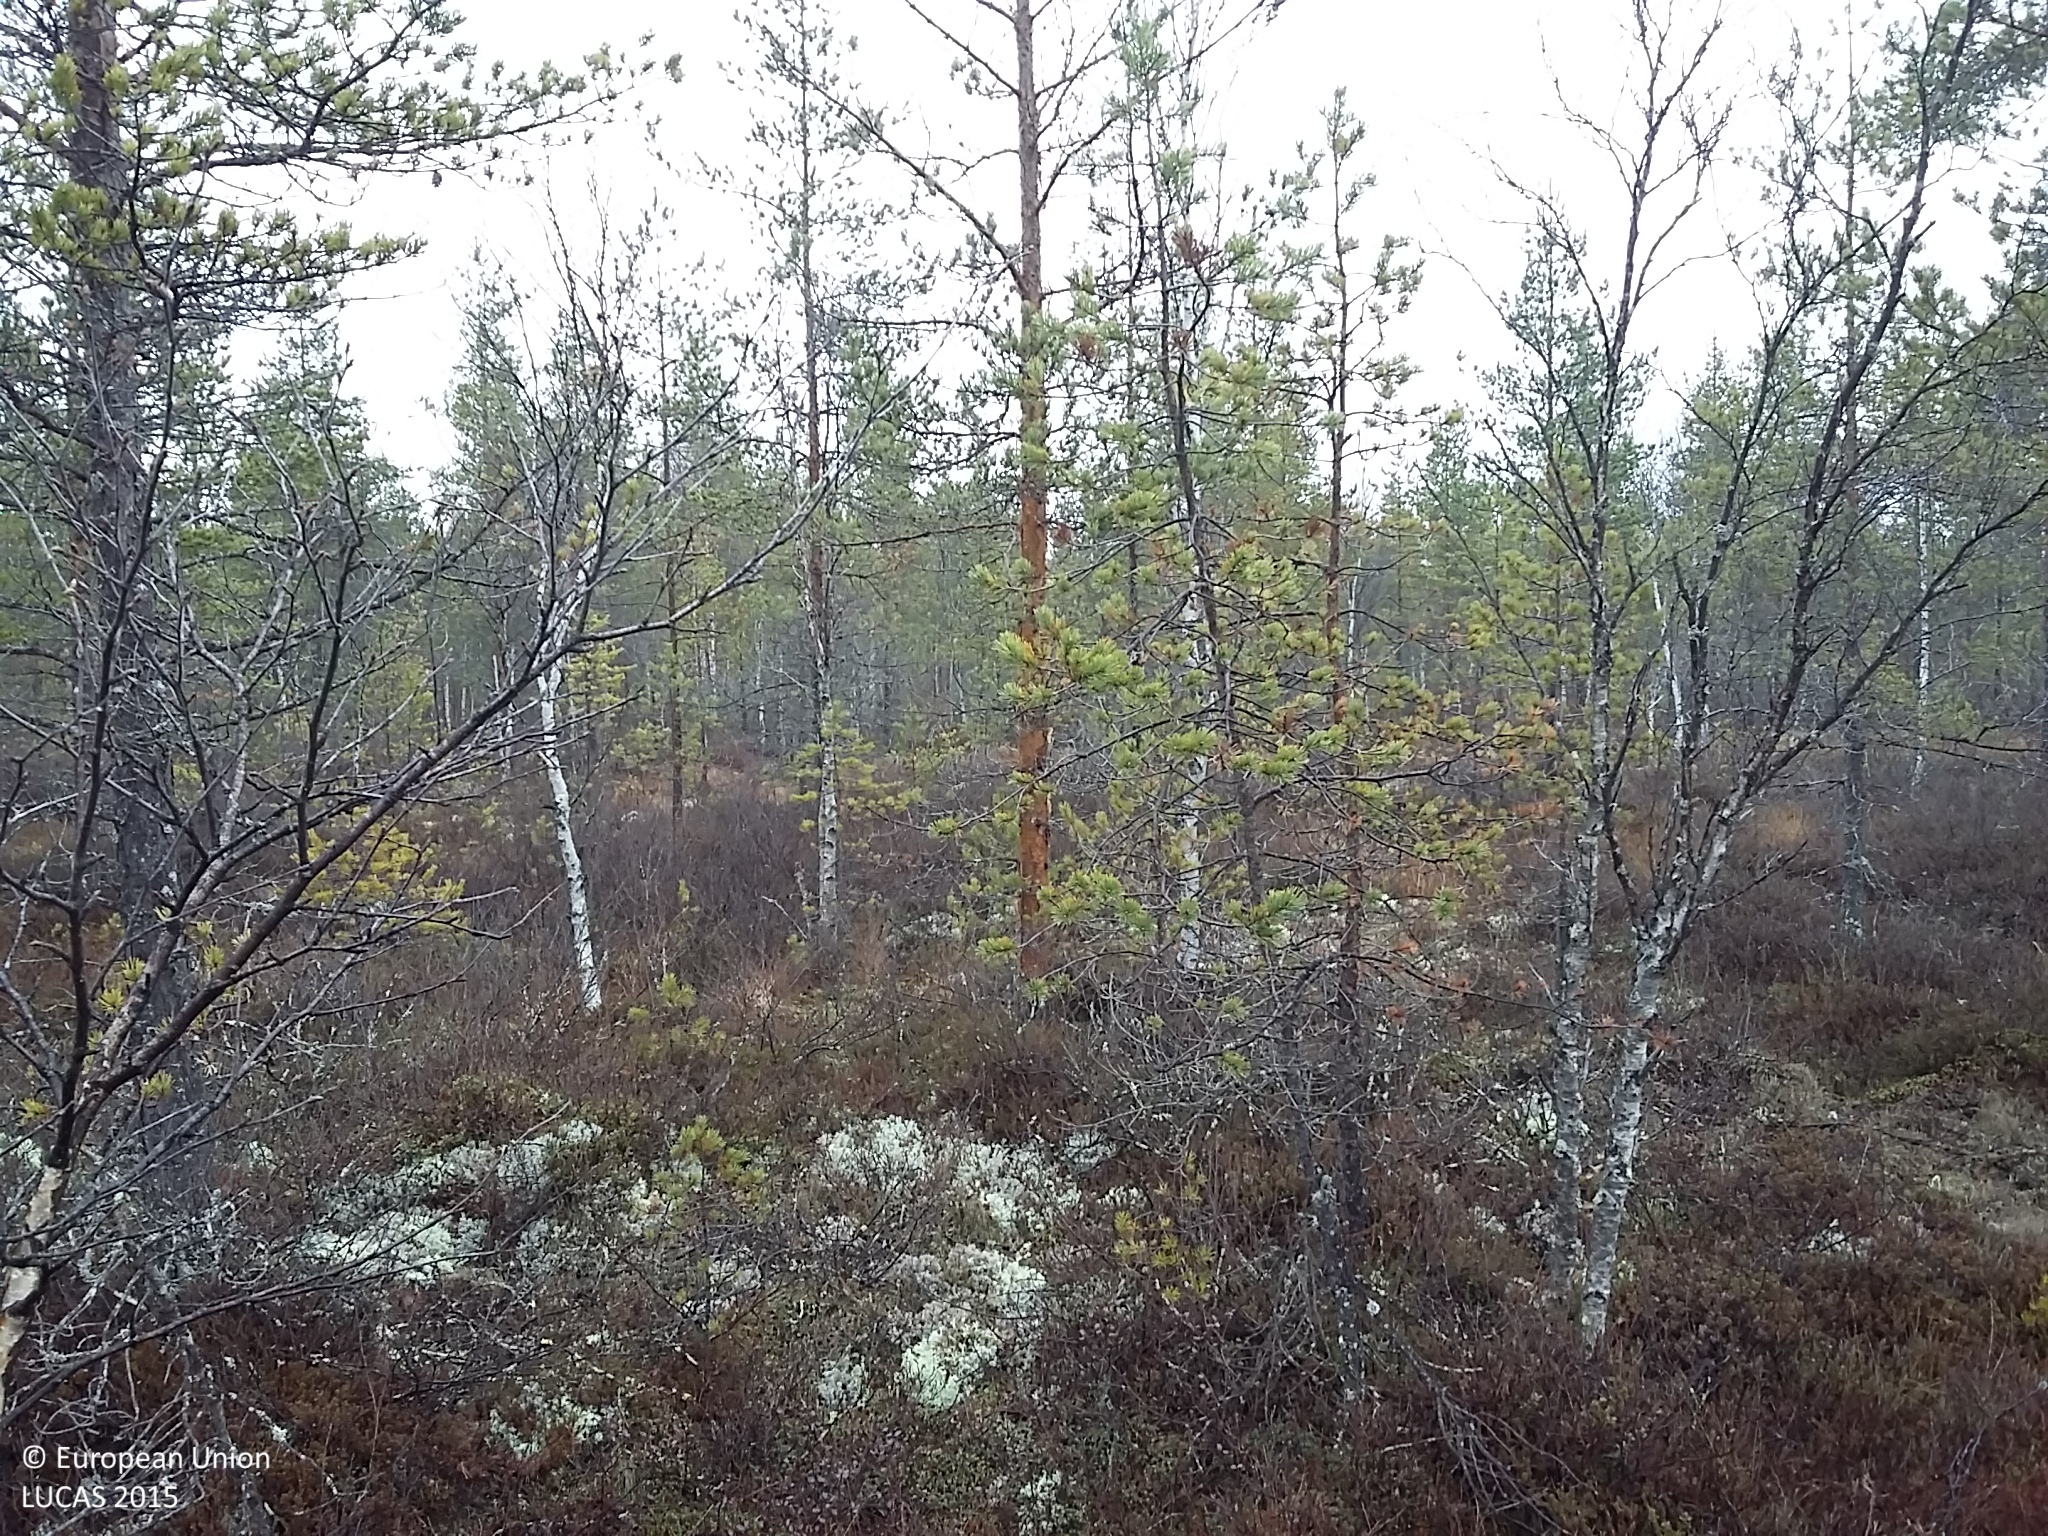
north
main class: Woodland
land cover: Pine dominated coniferous woodland
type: boreal forest
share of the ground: 50 - 75 %
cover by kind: coniferous forest trees 45 %, shrubs 25 %, lichens and mosses 20 %, broadleaved forest trees 5 %, herbaceous plants 5 %
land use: Forestry
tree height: > 5 m
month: October
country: FI
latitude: 64.4350
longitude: 25.3953
